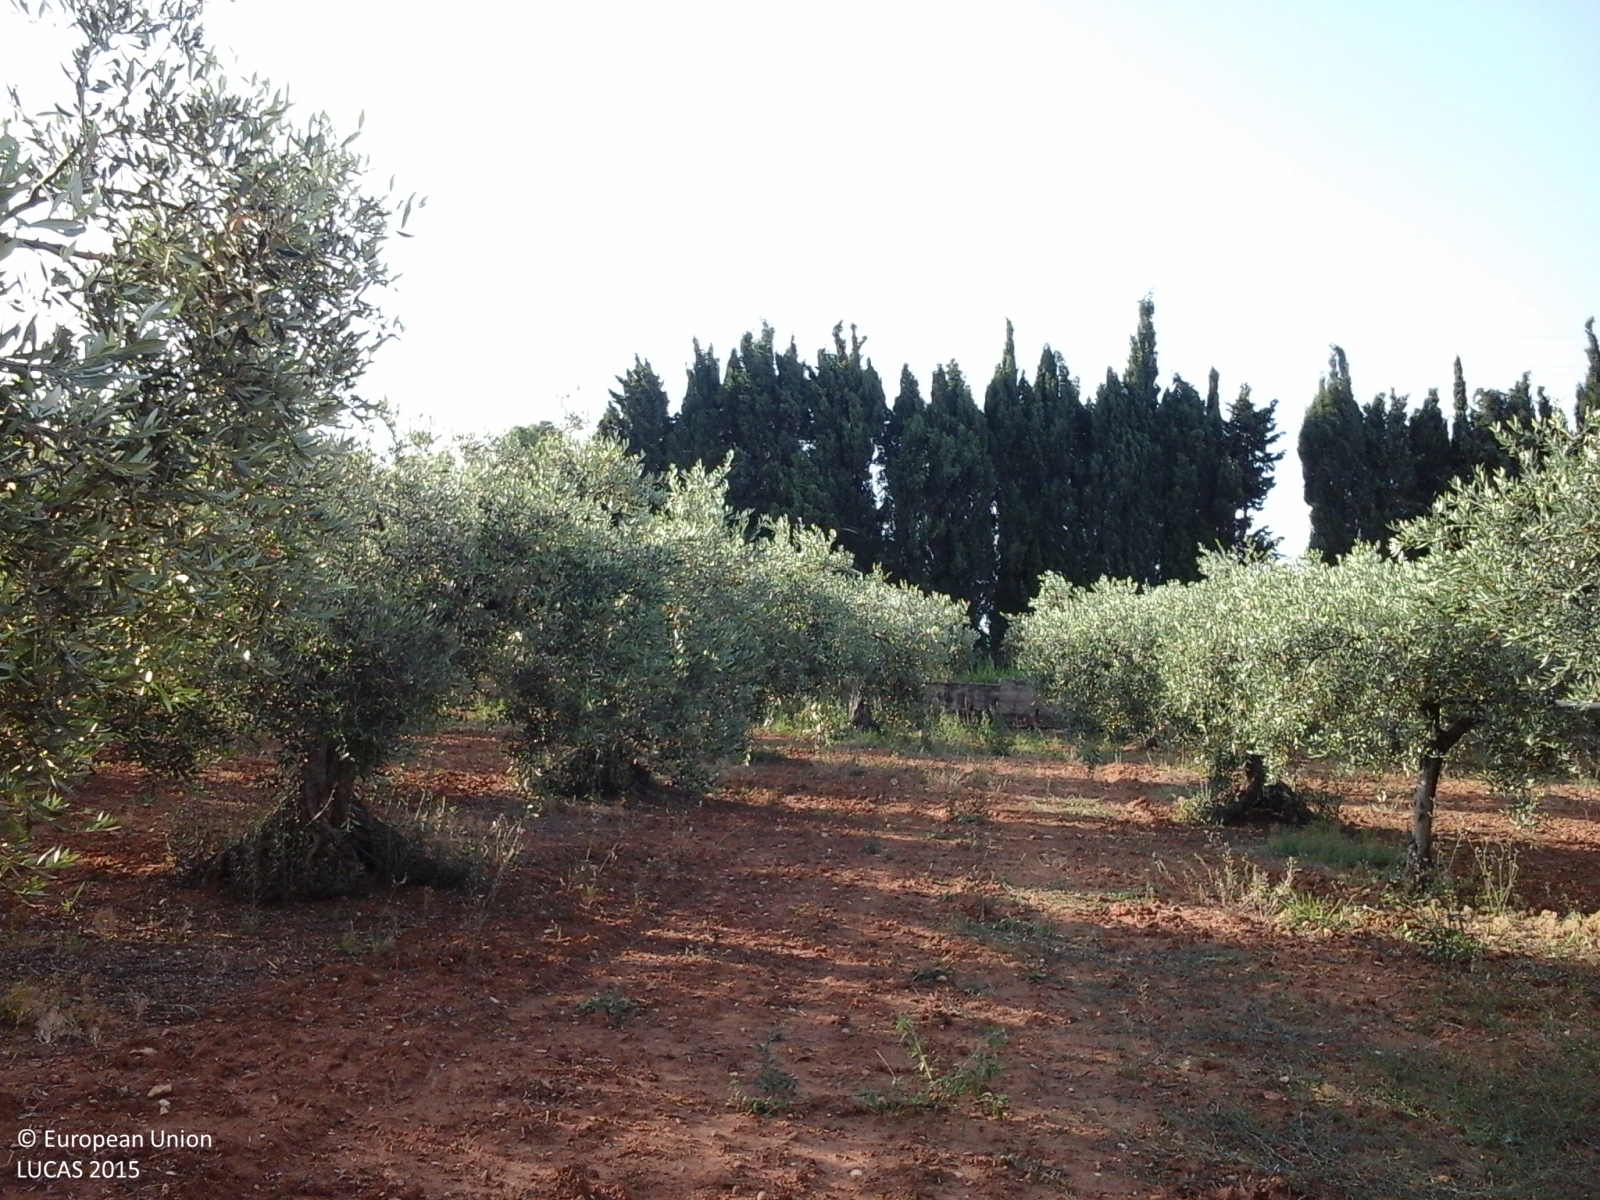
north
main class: Cropland
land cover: Olive groves
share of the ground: > 75 %
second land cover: Other bare soil
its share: > 75 %
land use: Agriculture (excluding fallow land and kitchen gardens)
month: May
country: IT
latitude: 37.6868
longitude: 12.8475
